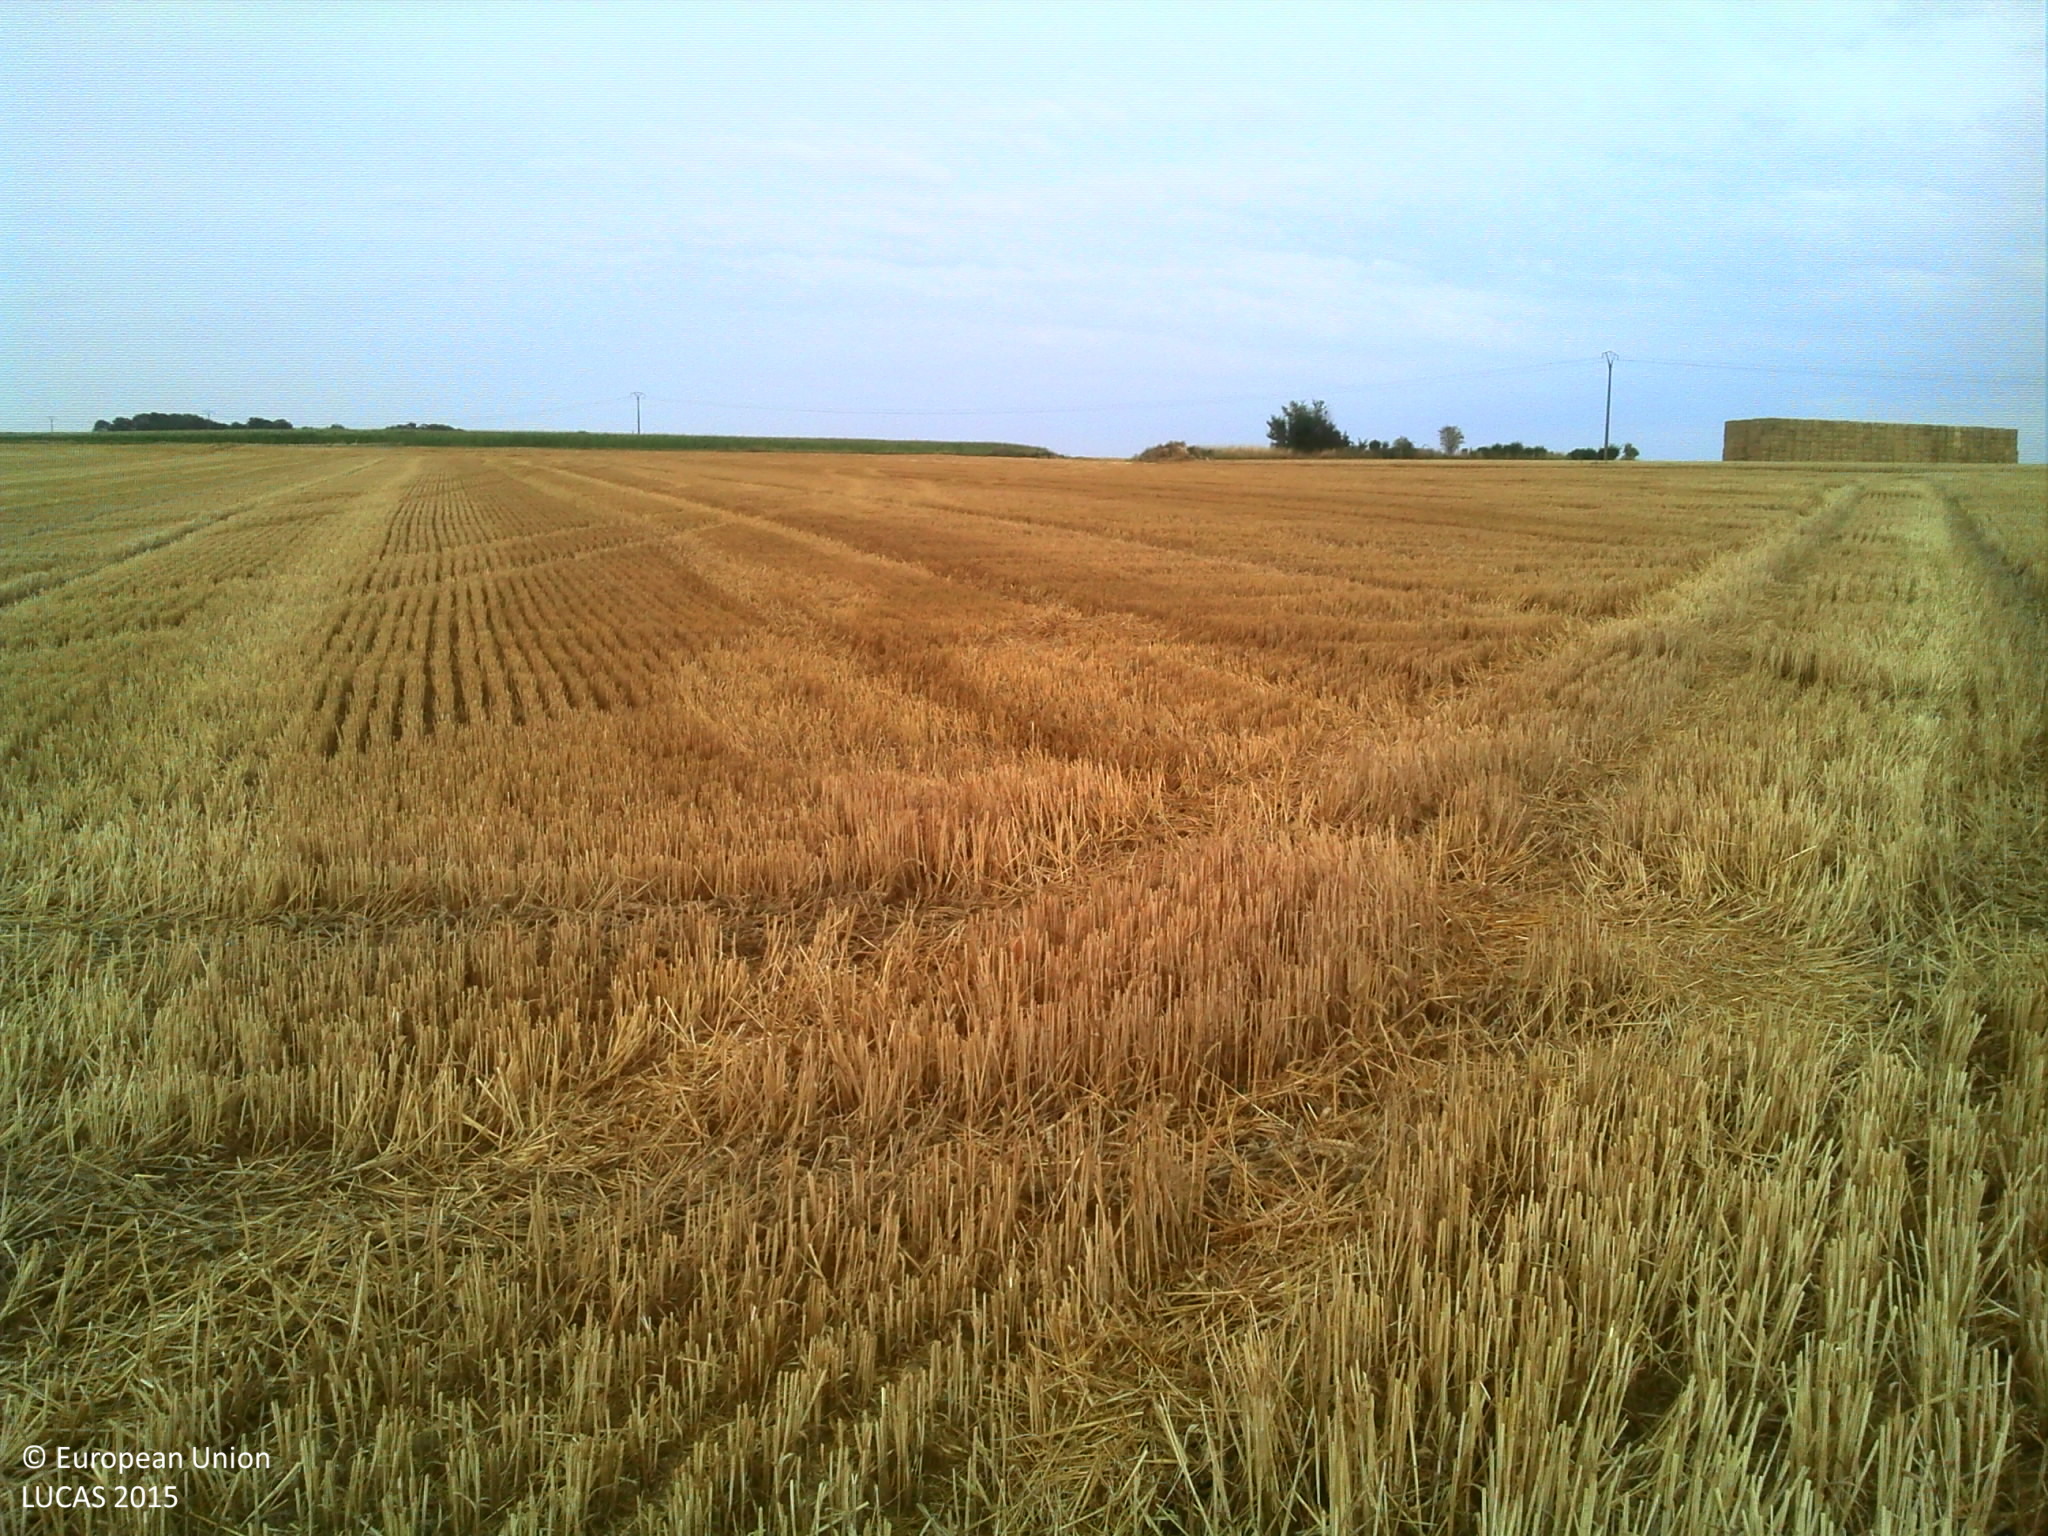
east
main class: Cropland
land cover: Common wheat
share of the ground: > 75 %
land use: Agriculture (excluding fallow land and kitchen gardens)
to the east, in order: Common wheat; Grass margins; Tracks; Grass margins; Common wheat; Grass margins; Tracks; Grass margins; Common wheat
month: August
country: FR
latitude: 48.8821
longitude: 2.9408
